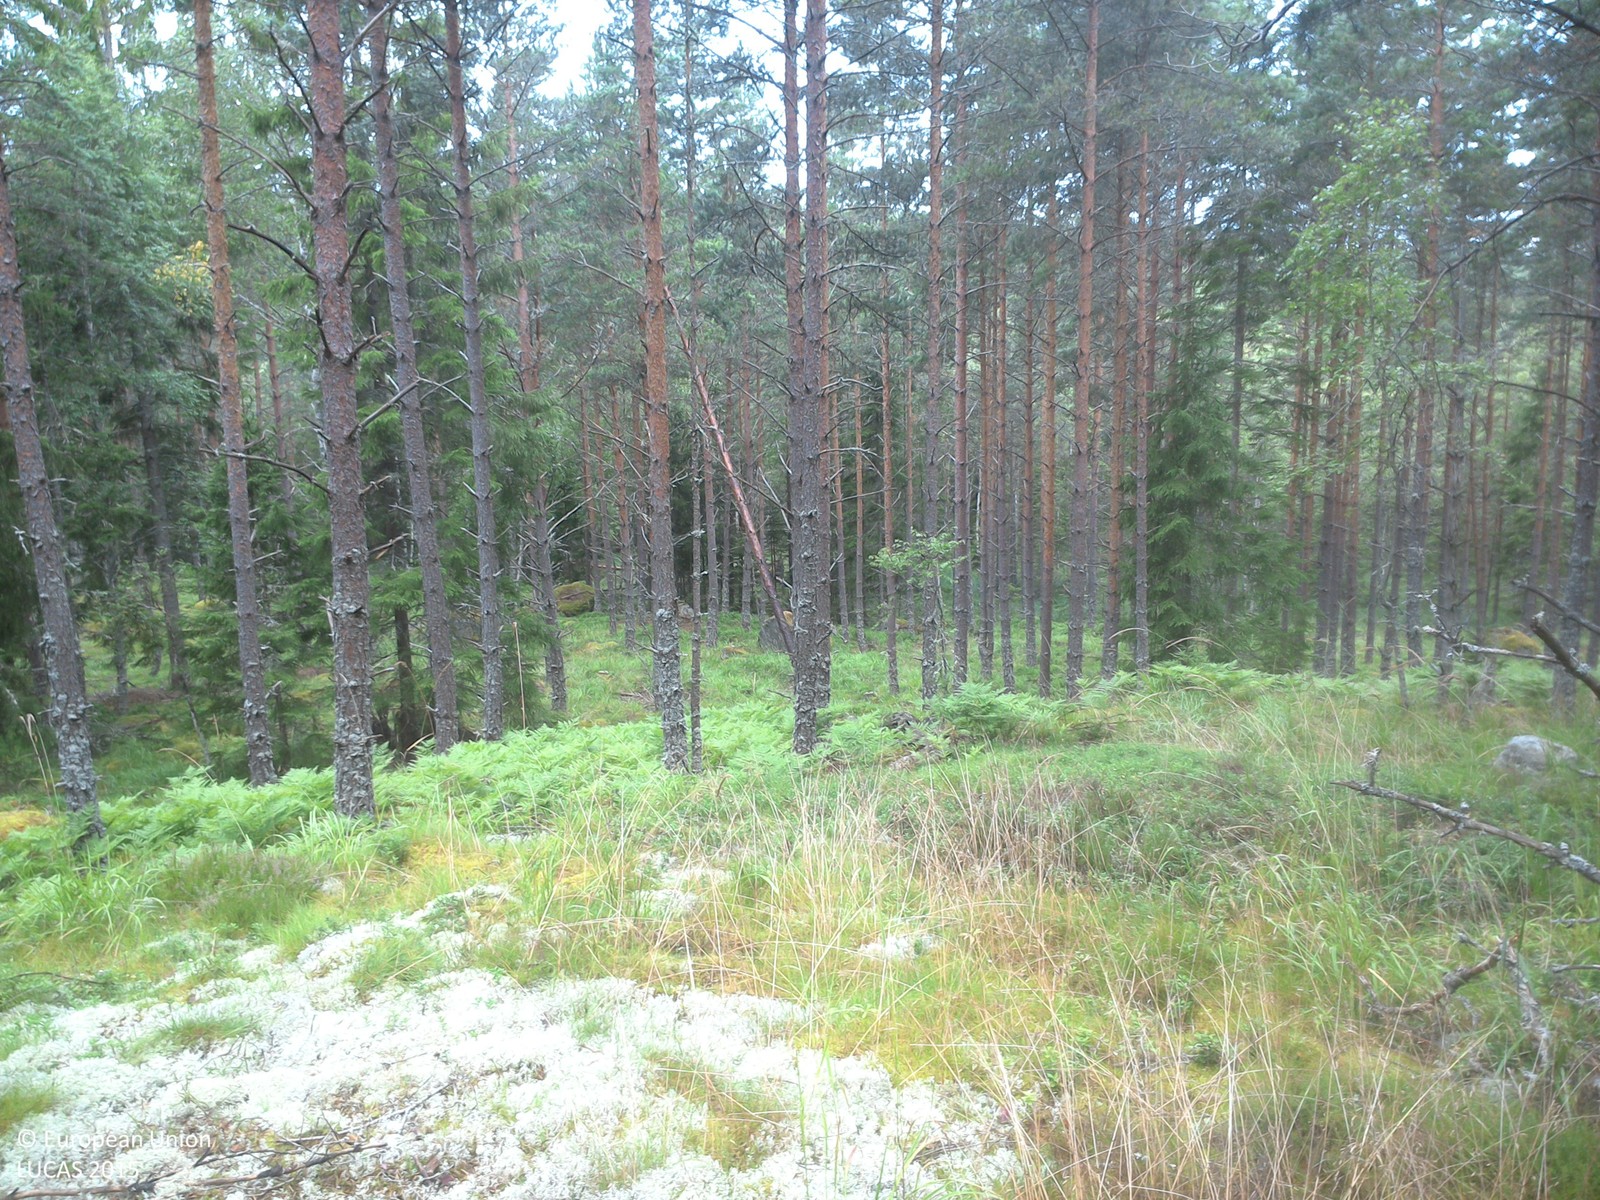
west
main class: Woodland
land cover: Pine dominated coniferous woodland
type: boreal forest
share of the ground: 25 - 50 %
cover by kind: coniferous forest trees 40 %, lichens and mosses 40 %, herbaceous plants 20 %
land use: Forestry
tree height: > 5 m
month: August
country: SE
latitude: 57.7164
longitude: 15.3510
